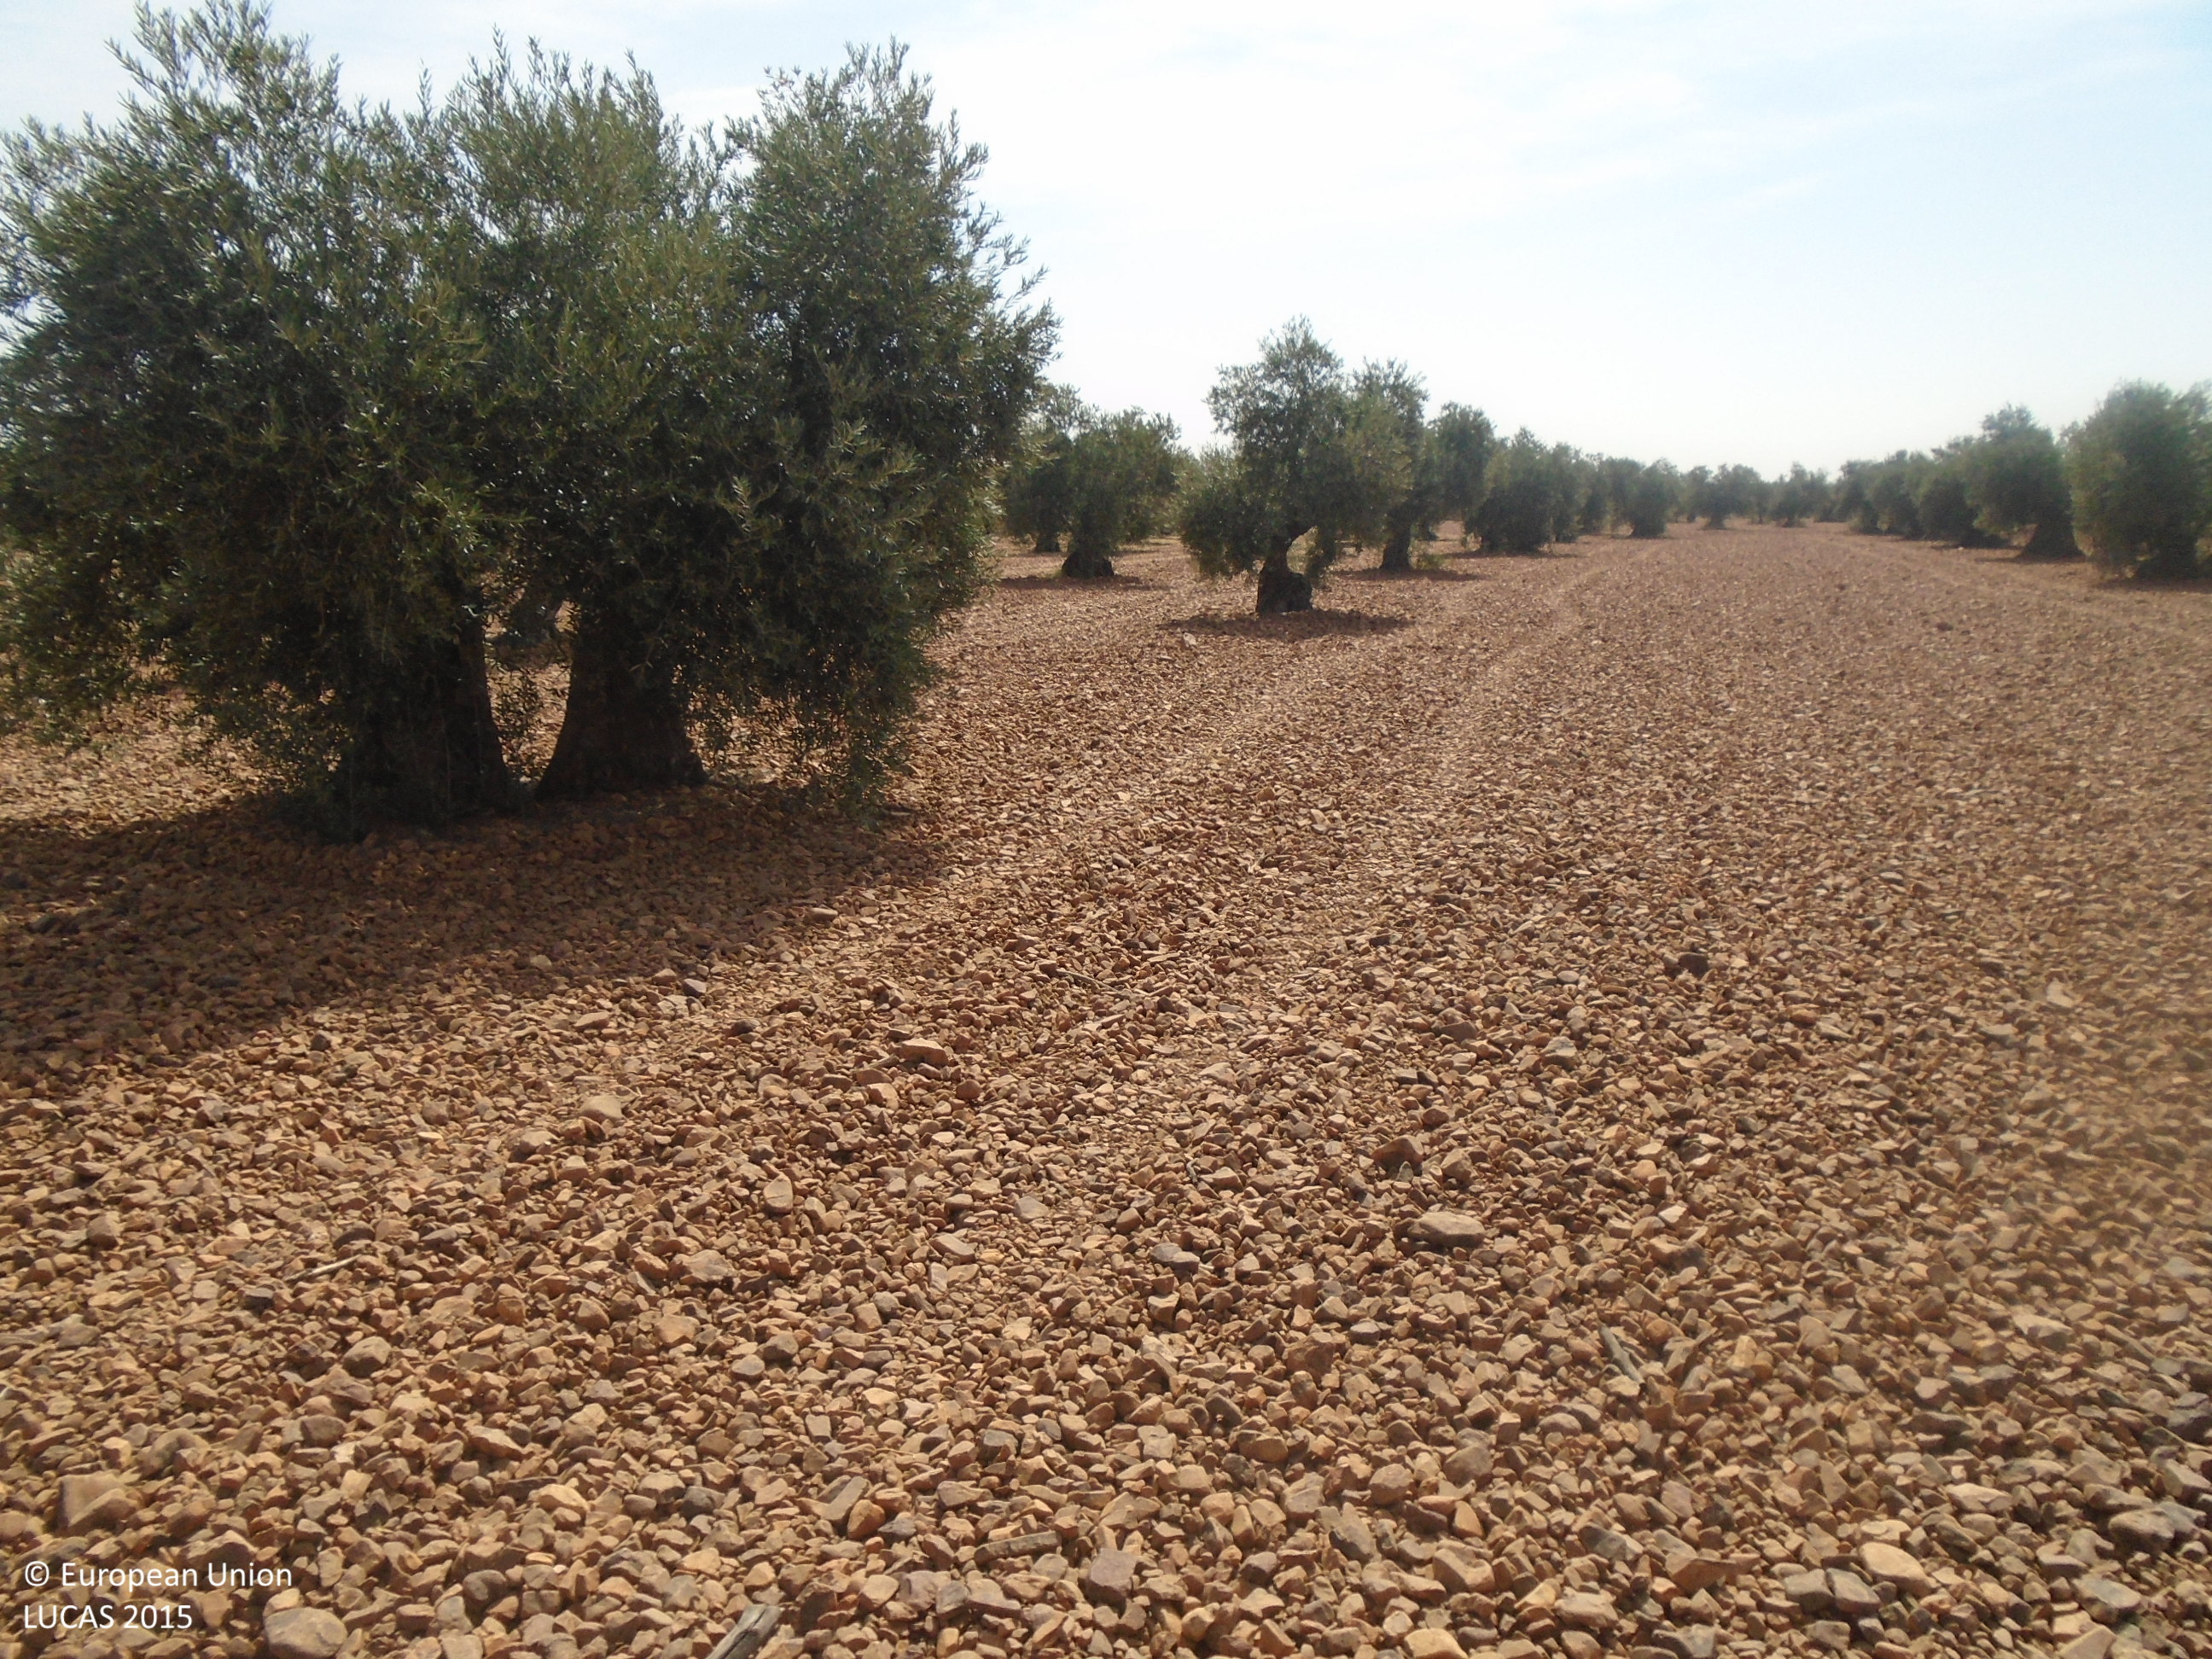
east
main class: Cropland
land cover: Olive groves
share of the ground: 25 - 50 %
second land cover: Other bare soil
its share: > 75 %
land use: Agriculture (excluding fallow land and kitchen gardens)
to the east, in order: Olive groves; Other bare soil; Tracks; Olive groves; Tracks; Olive groves
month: July
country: ES
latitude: 39.4137
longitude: -3.5531
